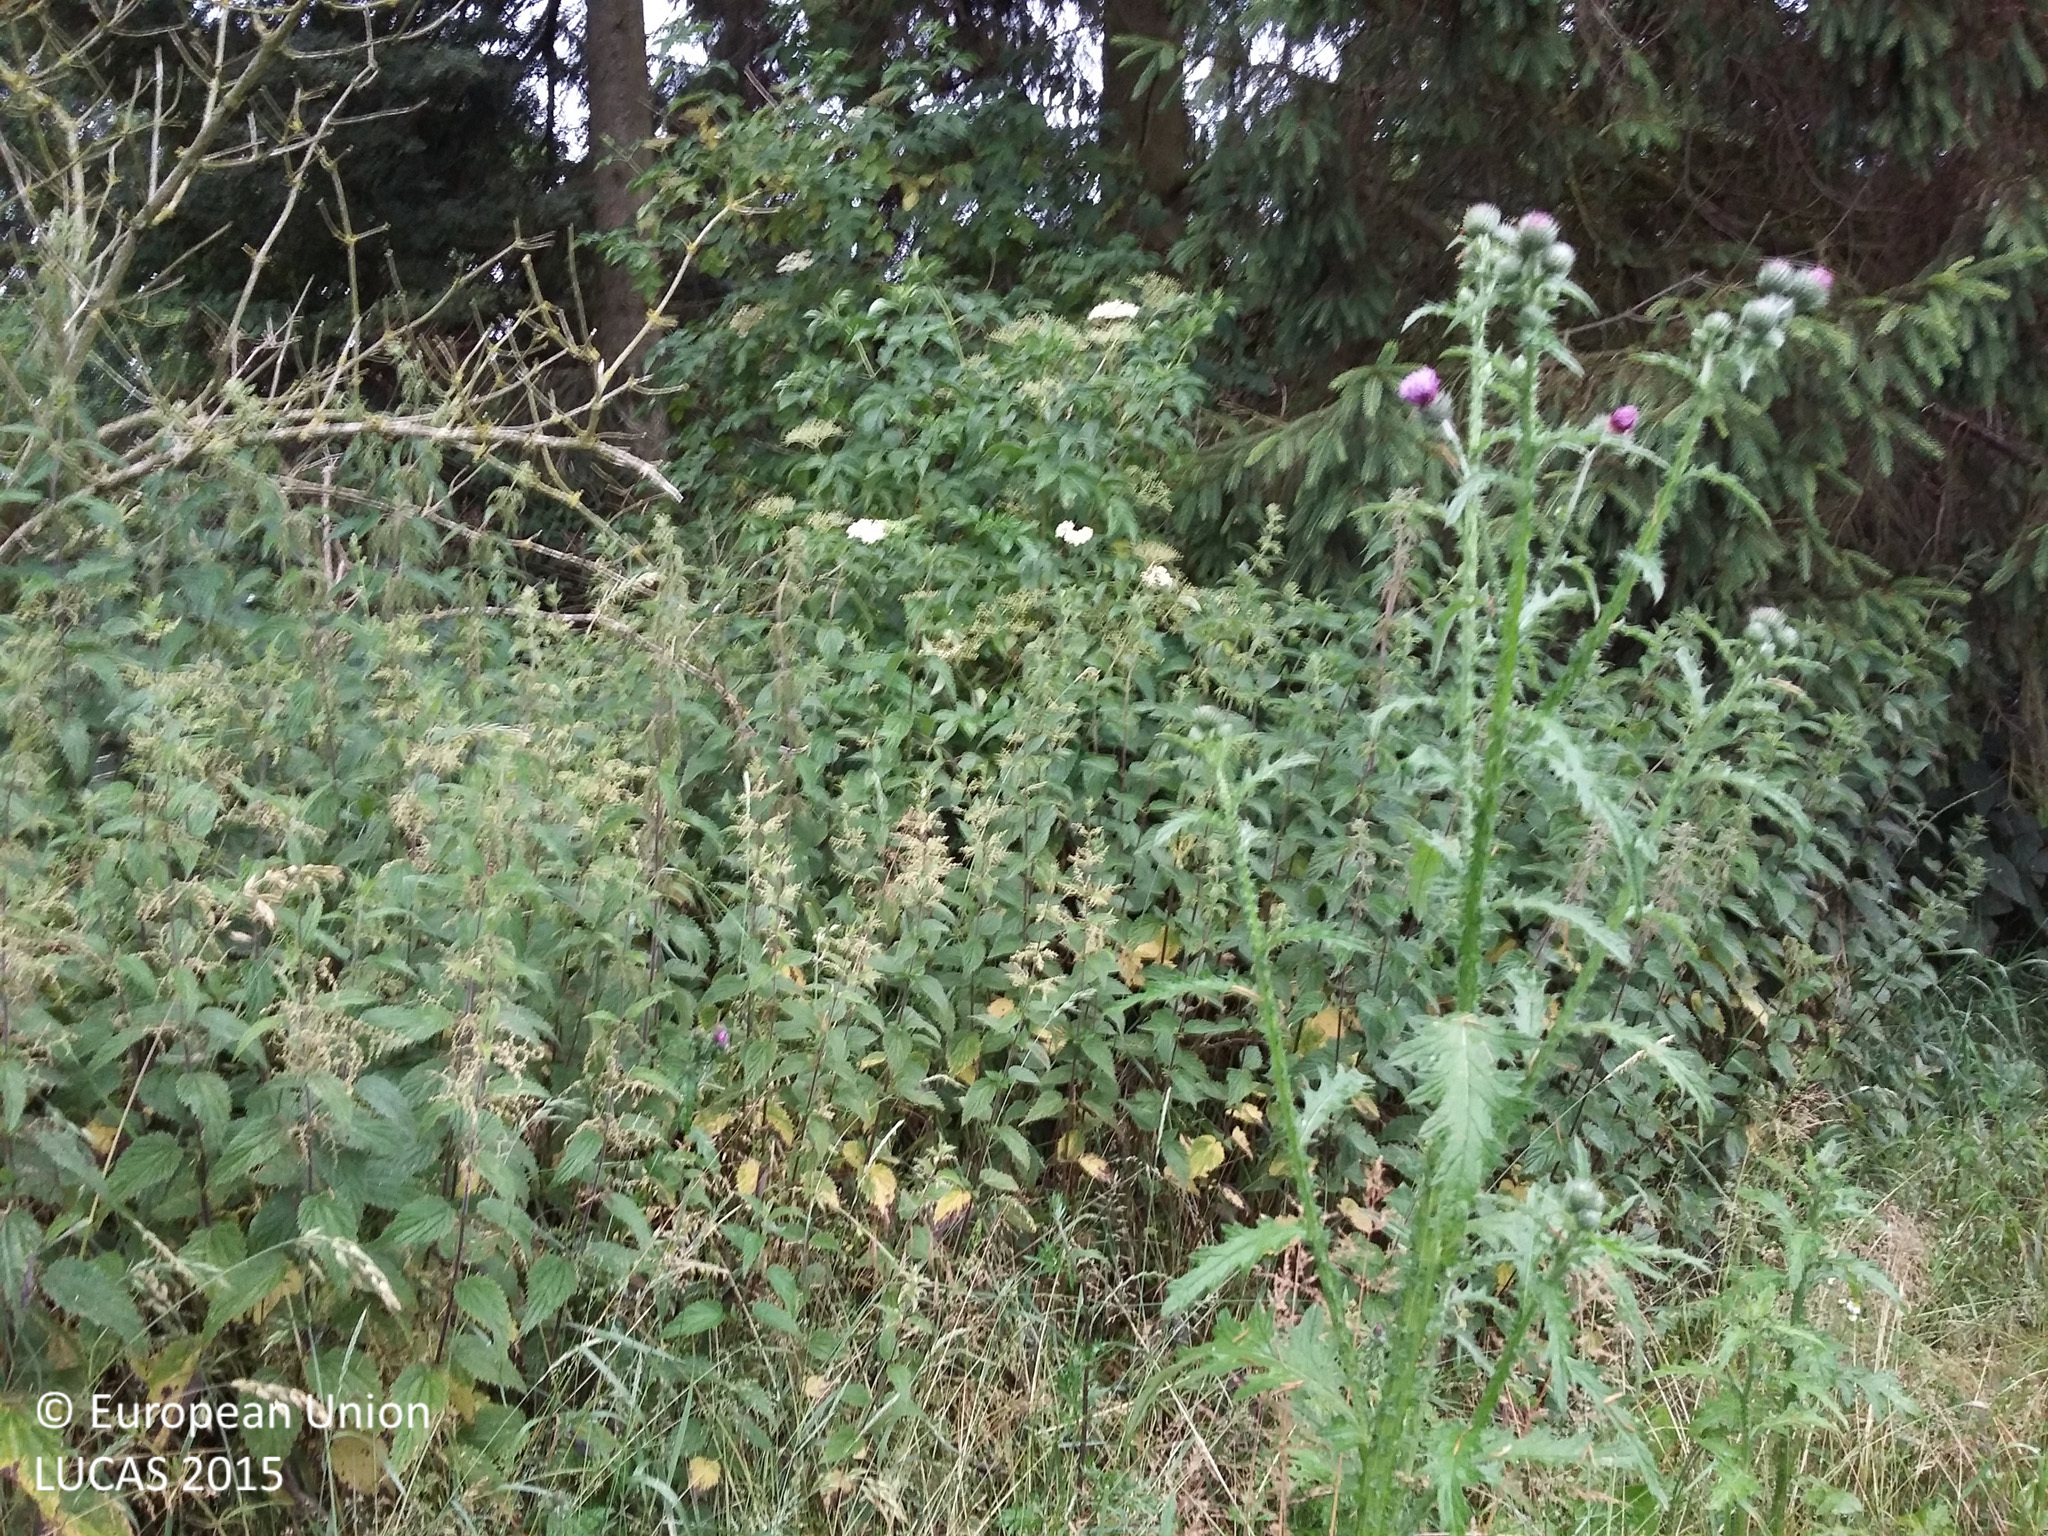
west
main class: Cropland
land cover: Rape and turnip rape
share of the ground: > 75 %
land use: Agriculture (excluding fallow land and kitchen gardens)
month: July
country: DK
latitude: 55.3321
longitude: 11.6538
